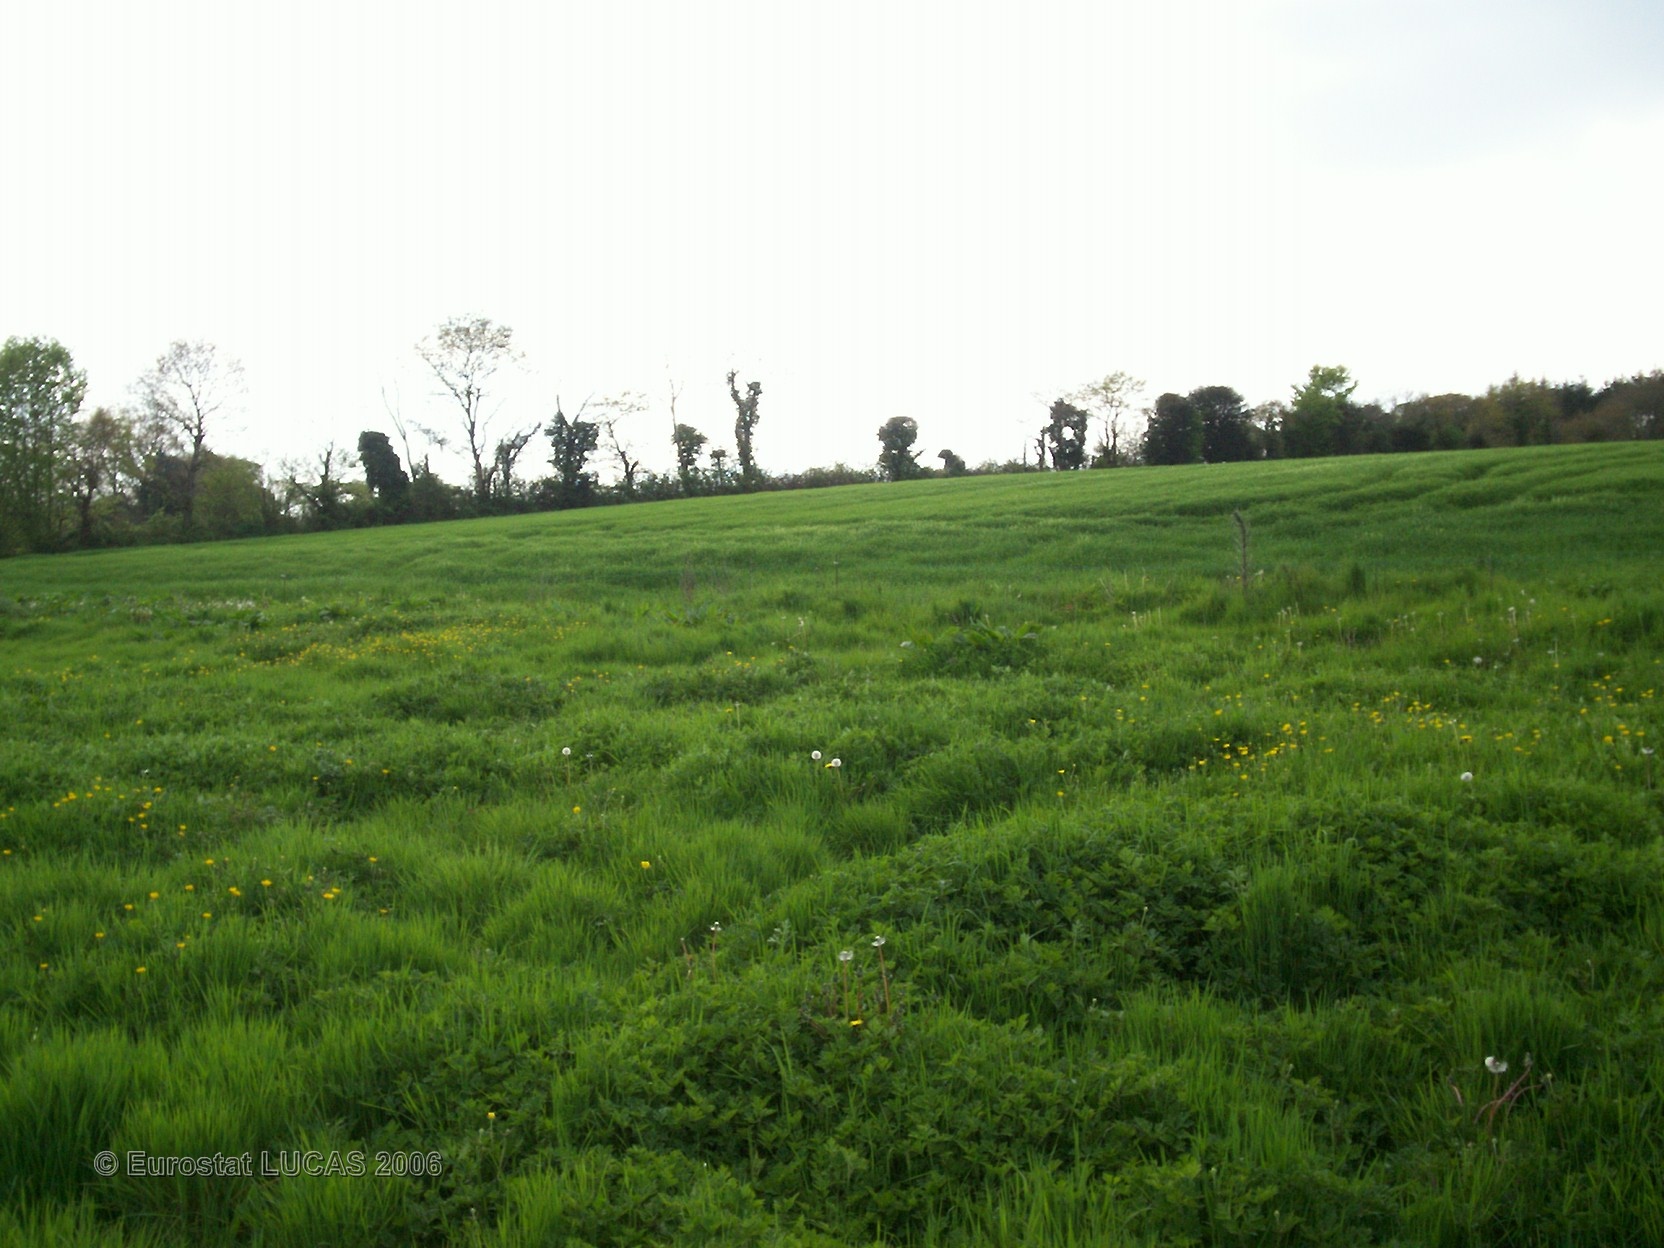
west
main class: Grassland
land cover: Grassland without tree/shrub cover
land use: Agriculture (excluding fallow land and kitchen gardens)
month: May
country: FR
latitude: 48.4295
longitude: -3.6368
